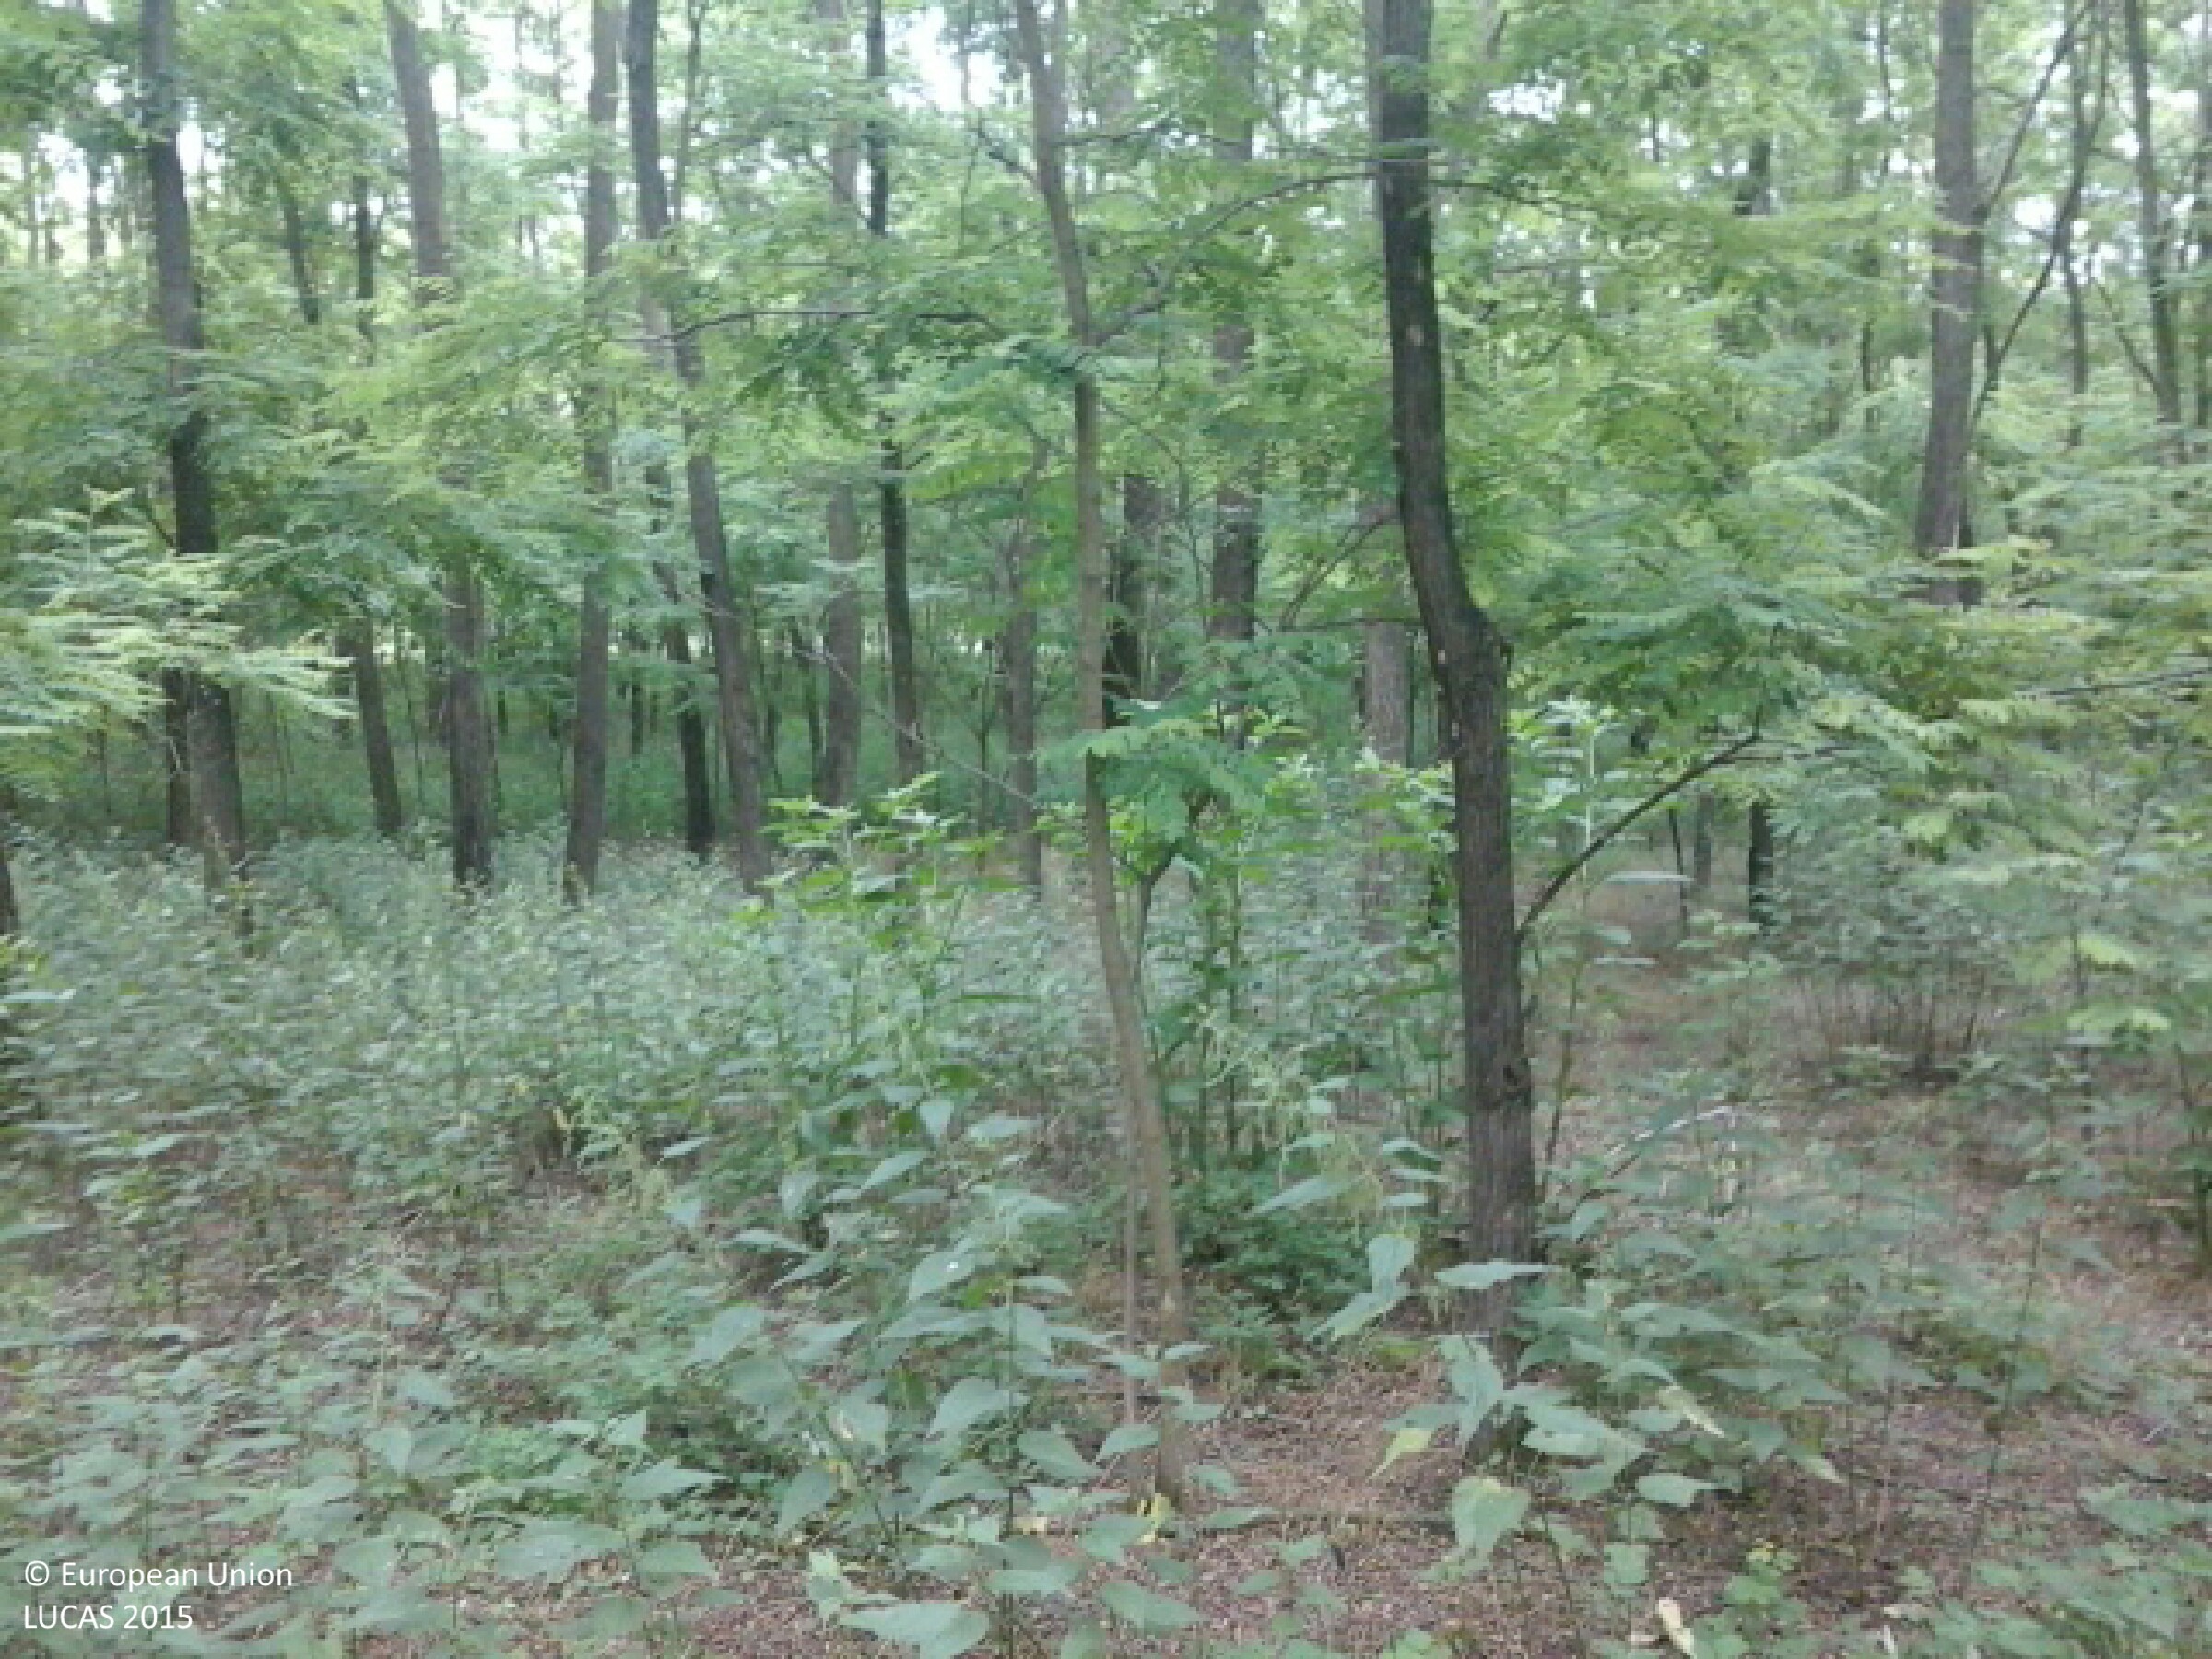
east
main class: Woodland
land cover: Broadleaved woodland
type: mesophytic deciduous forest
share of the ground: > 75 %
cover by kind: broadleaved forest trees 95 %, herbaceous plants 5 %
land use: Forestry
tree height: > 5 m
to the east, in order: Broadleaved woodland; Ditches and canals; Paved roads, cycling and walking lanes; Ditches and canals; Broadleaved woodland
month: June
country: HU
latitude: 47.9731
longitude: 22.0960
